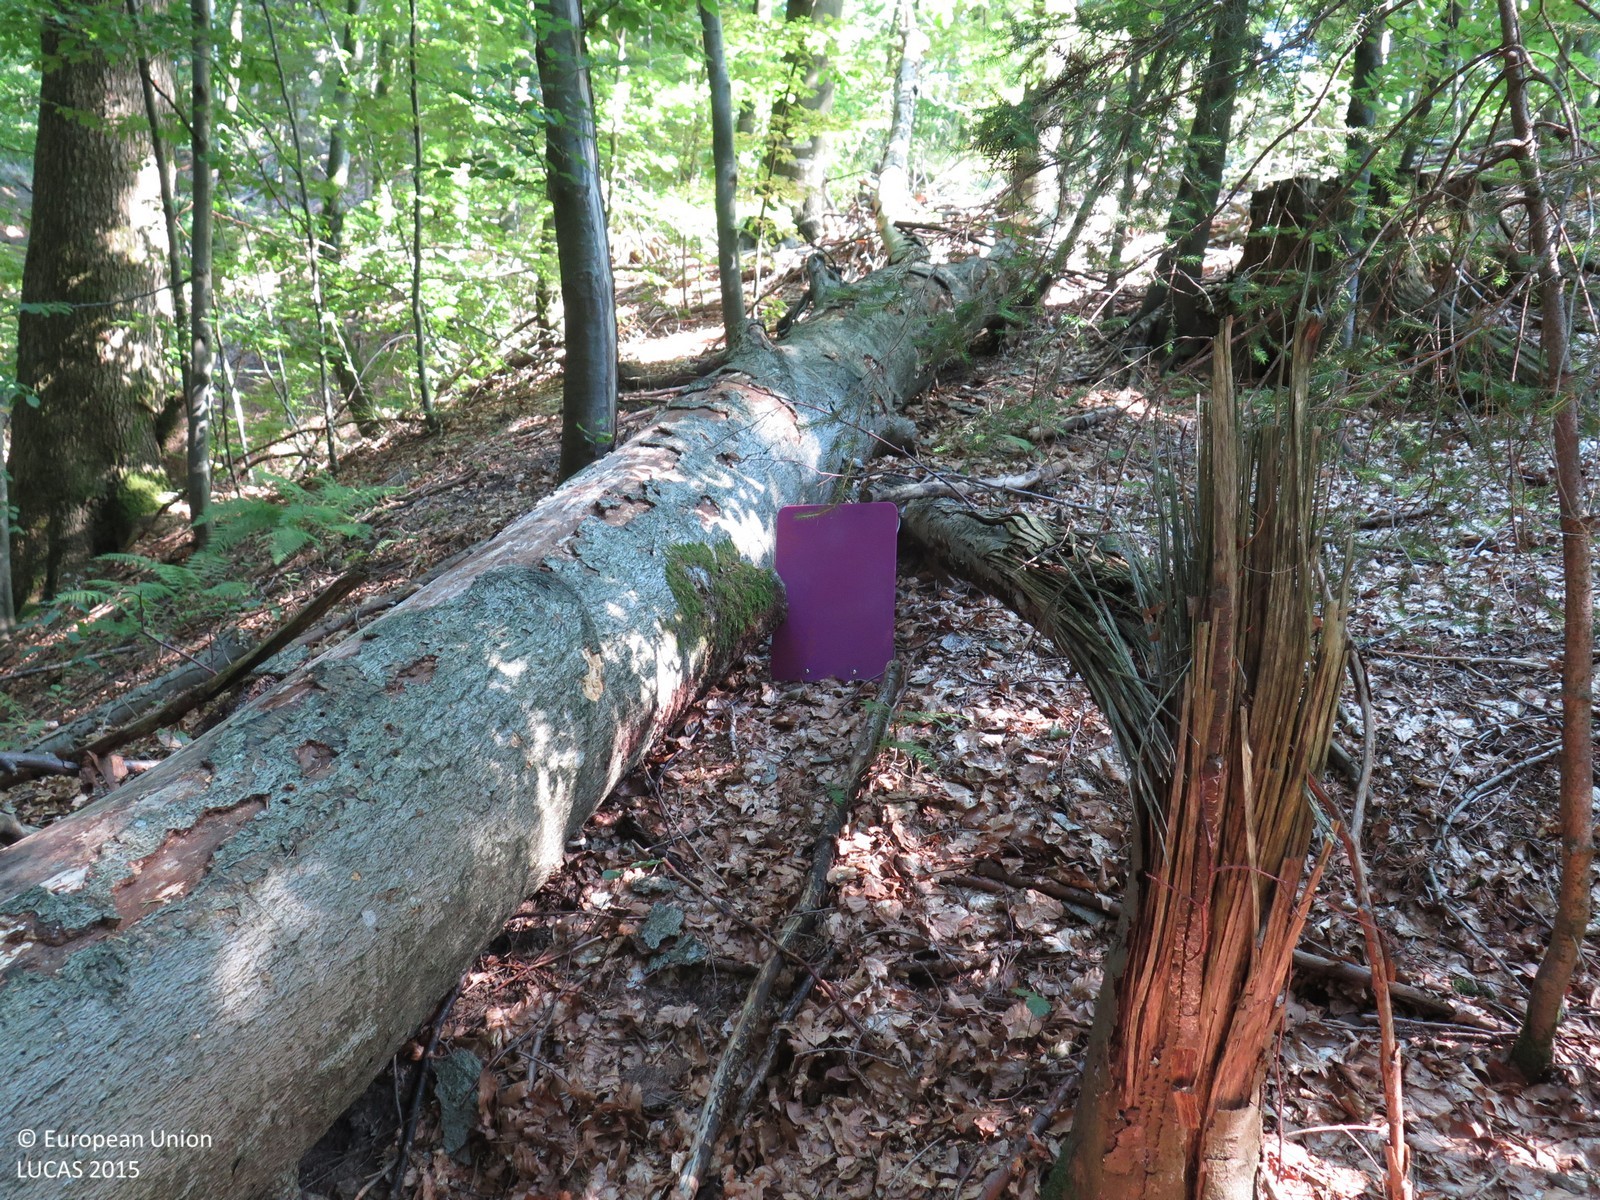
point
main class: Woodland
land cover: Broadleaved woodland
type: beech forest
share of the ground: > 75 %
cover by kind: broadleaved forest trees 100 %
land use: Forestry
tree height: > 5 m
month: August
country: HR
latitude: 45.3477
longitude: 14.6537
